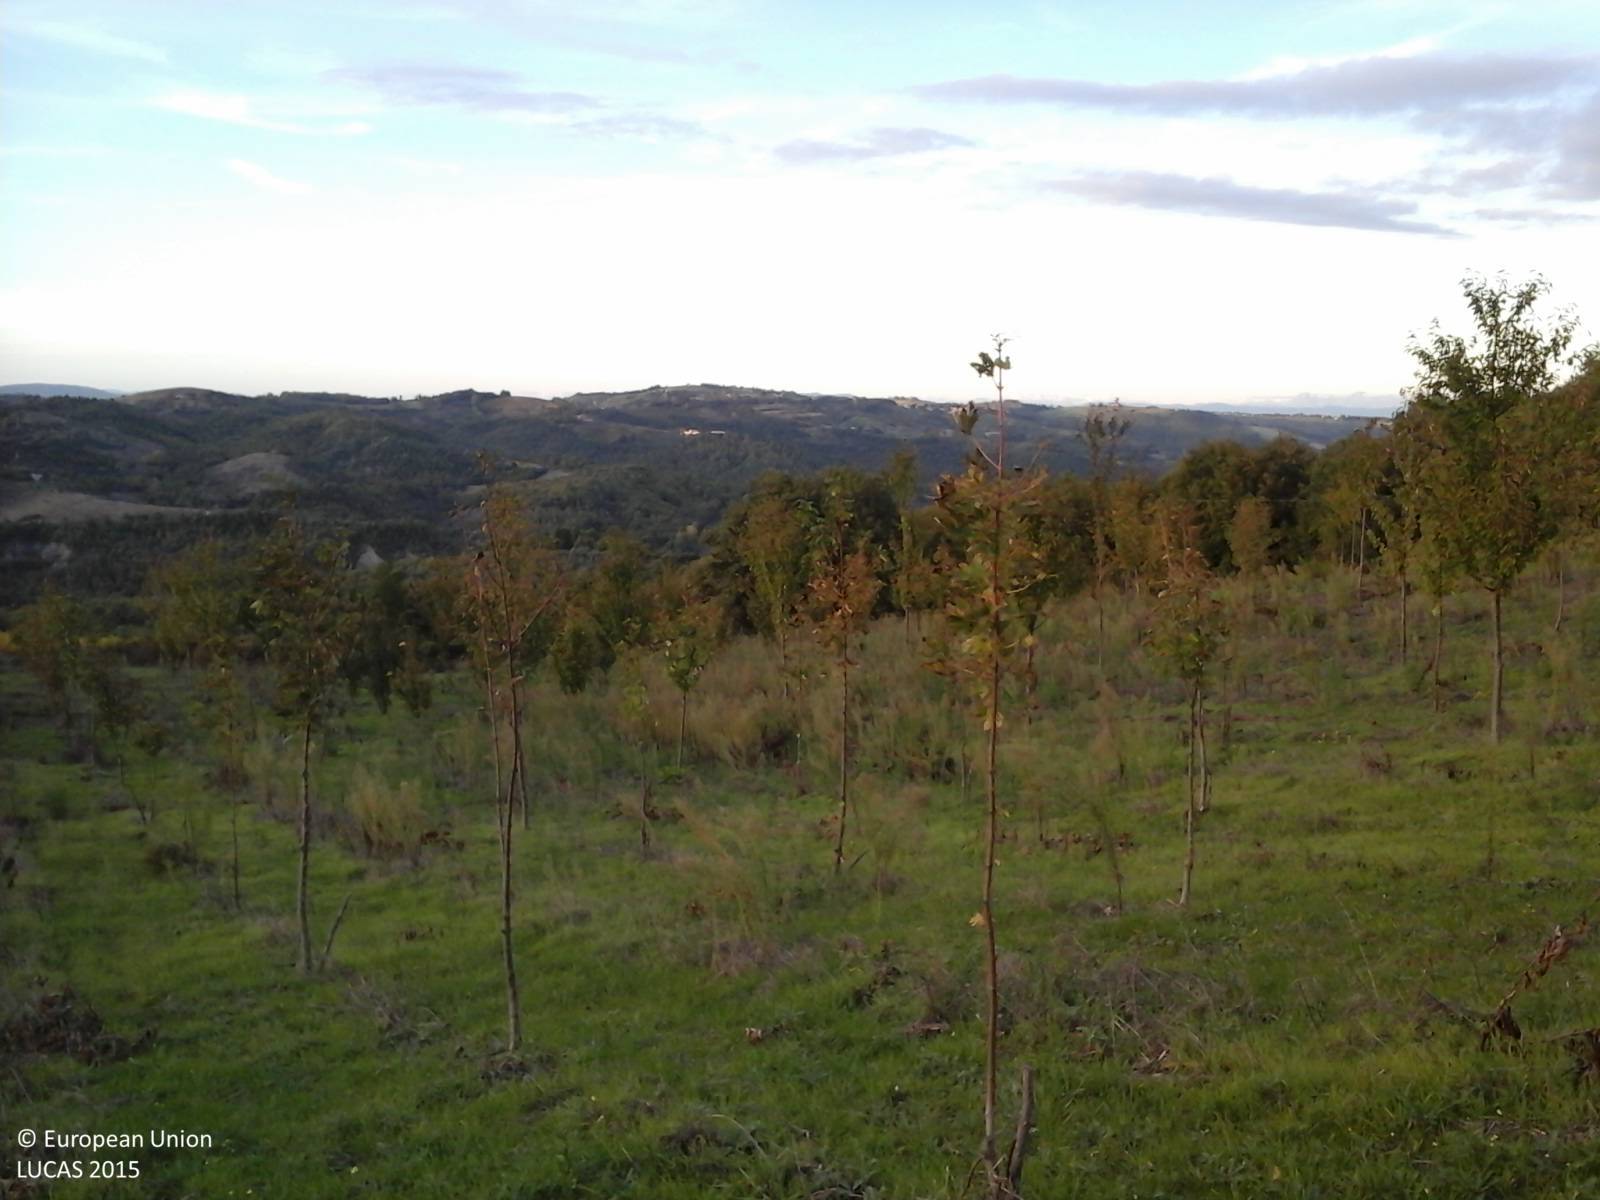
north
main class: Cropland
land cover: Cherry fruit
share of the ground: 50 - 75 %
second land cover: Spontaneously vegetated surfaces
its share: > 75 %
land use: Agriculture (excluding fallow land and kitchen gardens)
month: October
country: IT
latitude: 42.8085
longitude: 12.3041
